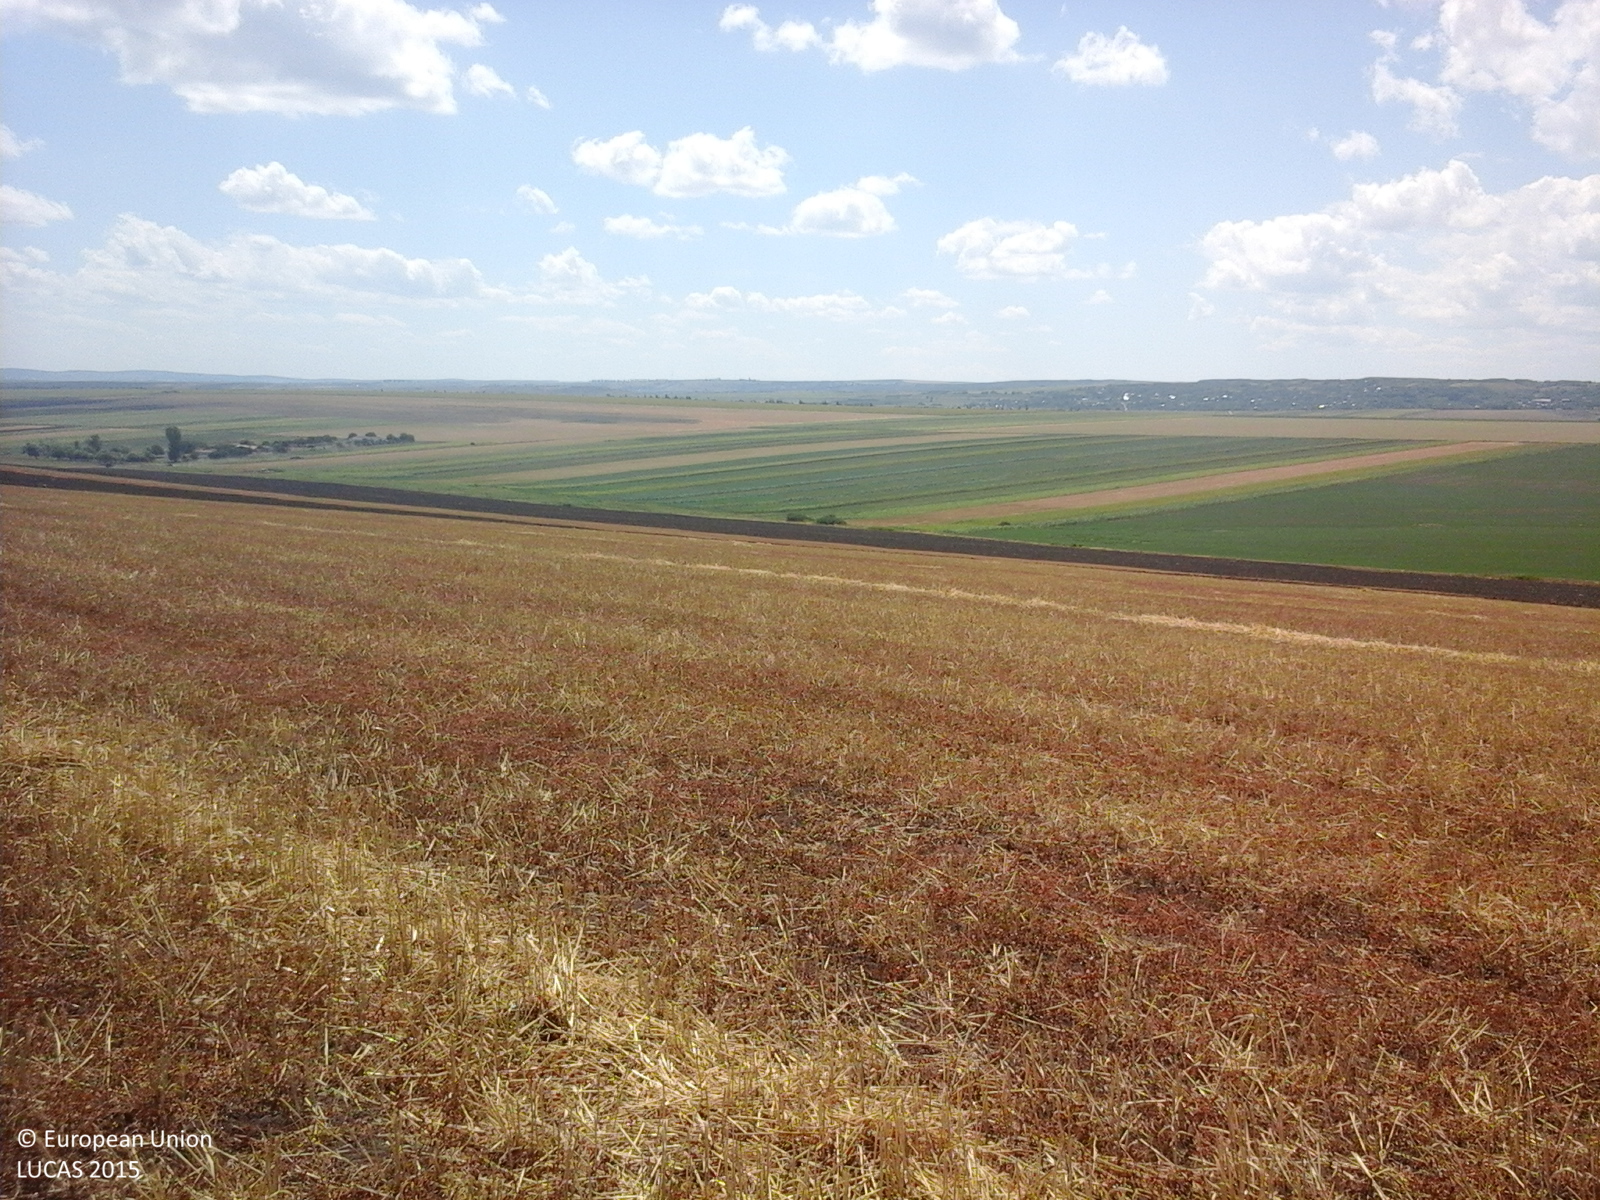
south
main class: Cropland
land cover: Common wheat
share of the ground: > 75 %
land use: Agriculture (excluding fallow land and kitchen gardens)
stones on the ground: < 10 %
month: July
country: RO
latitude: 46.4051
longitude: 27.9309
